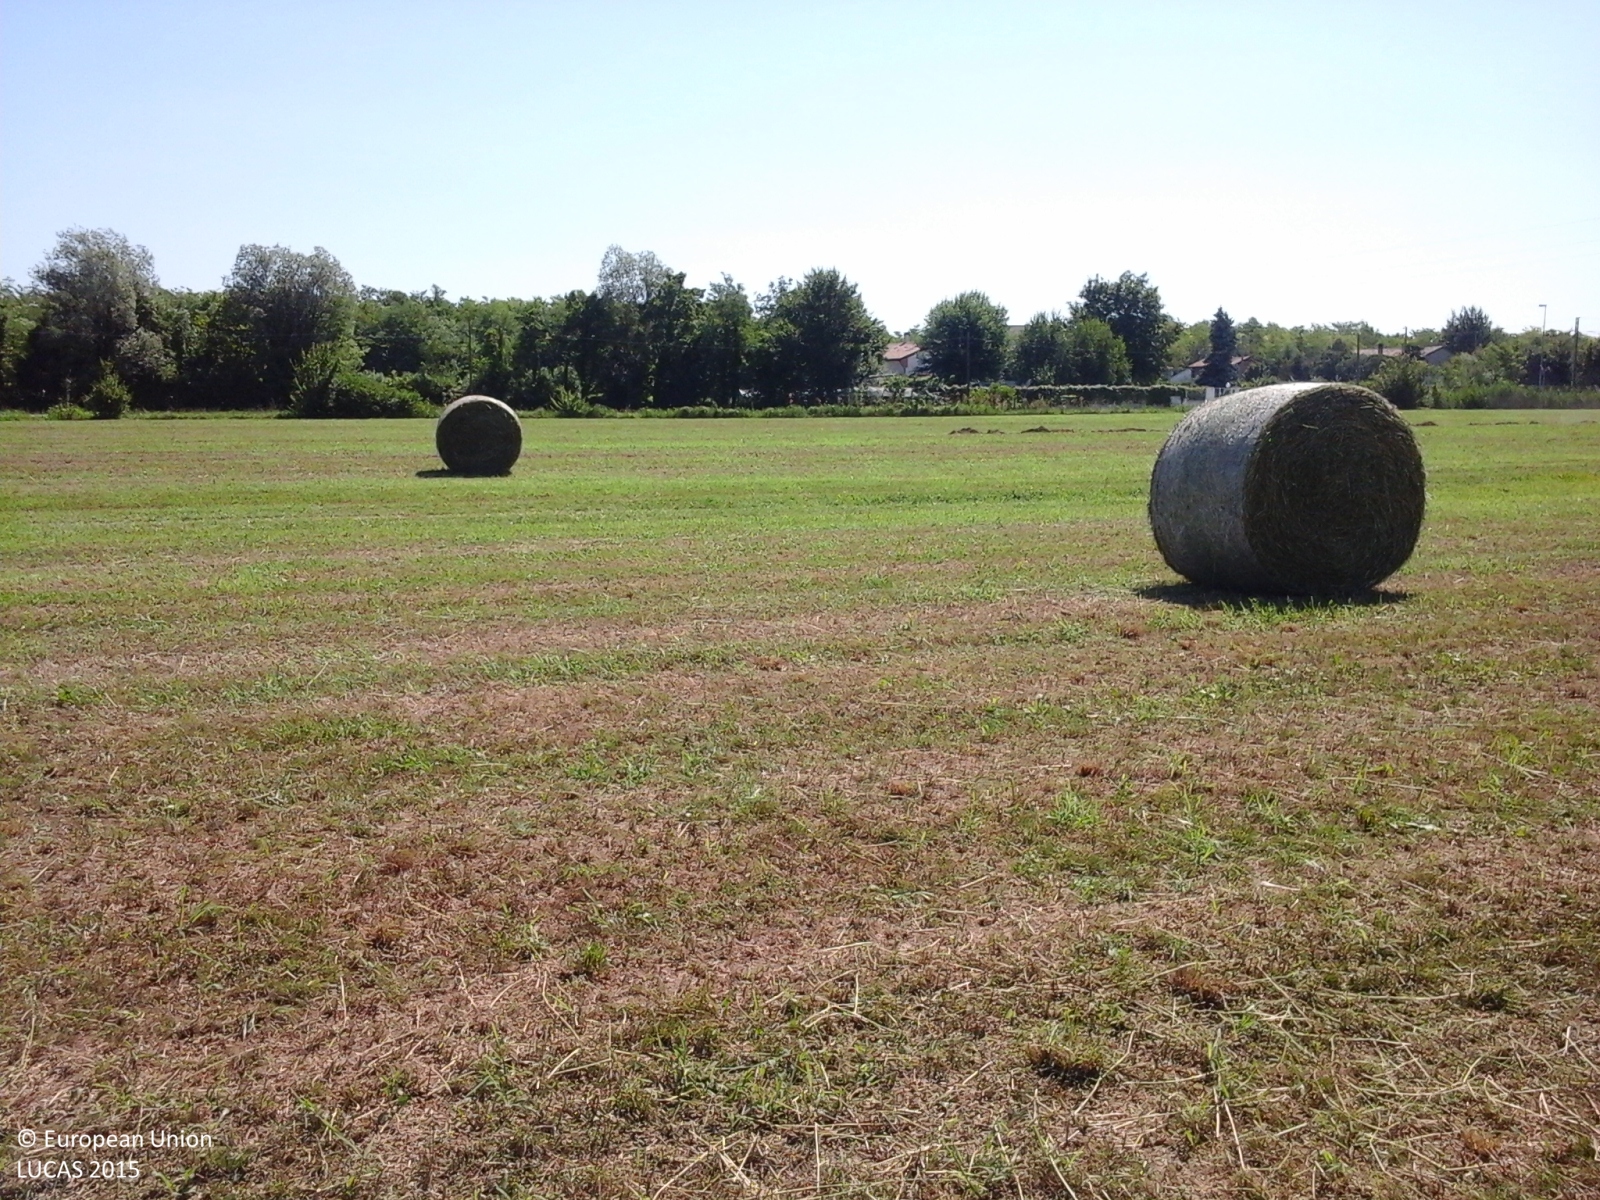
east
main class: Grassland
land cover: Grassland without tree/shrub cover
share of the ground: > 75 %
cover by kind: herbaceous plants 100 %
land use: Agriculture (excluding fallow land and kitchen gardens)
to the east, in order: Grassland without tree/shrub cover; Ditches and canals; Grassland without tree/shrub cover; Ditches and canals; Grass margins; Paved roads, cycling and walking lanes; Electric lines; Soya; Managed hedges; Ditches and canals; Managed hedges; Other fresh vegetables; Broadleaved woodland; Electric lines; Broadleaved woodland; Ditches and canals; Lines of trees; Grassland without tree/shrub cover
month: July
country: IT
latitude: 45.6772
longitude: 12.3203
